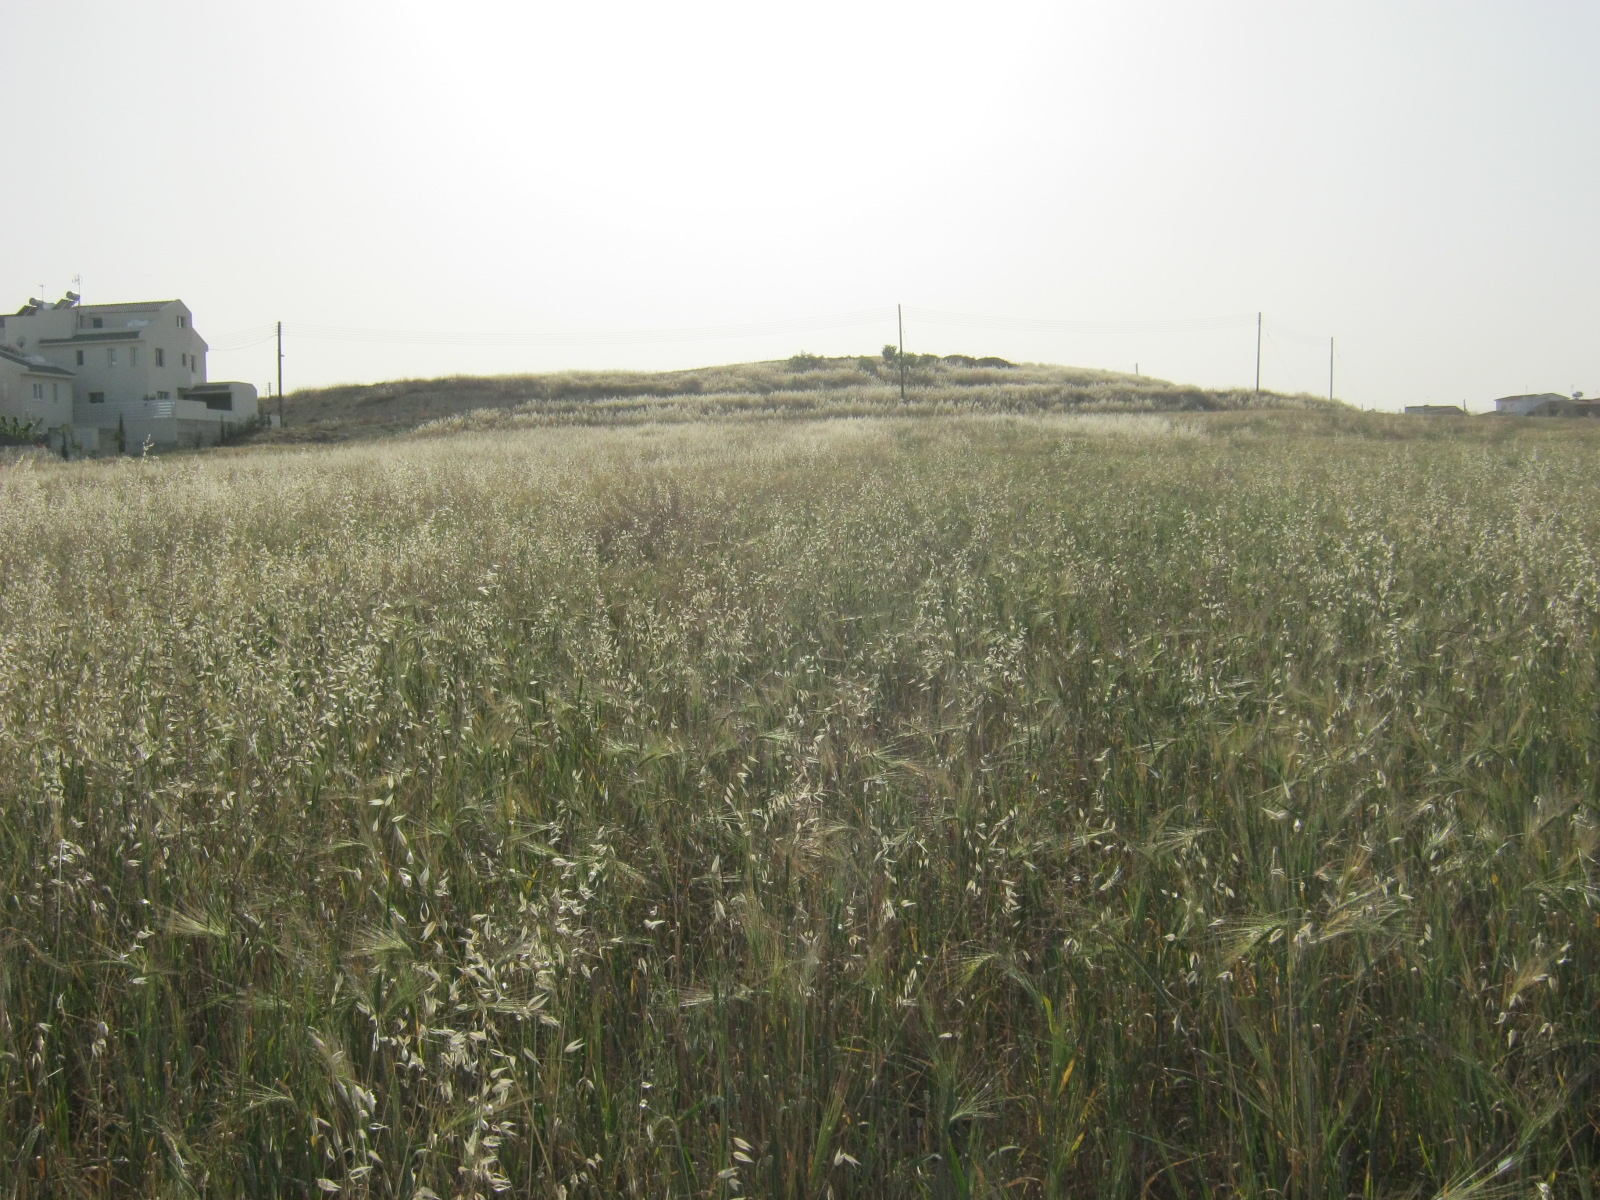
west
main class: Cropland
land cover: Mixed cereals for fodder
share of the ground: > 75 %
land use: Agriculture (excluding fallow land and kitchen gardens)
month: April
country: CY
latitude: 35.1164
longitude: 33.4231
